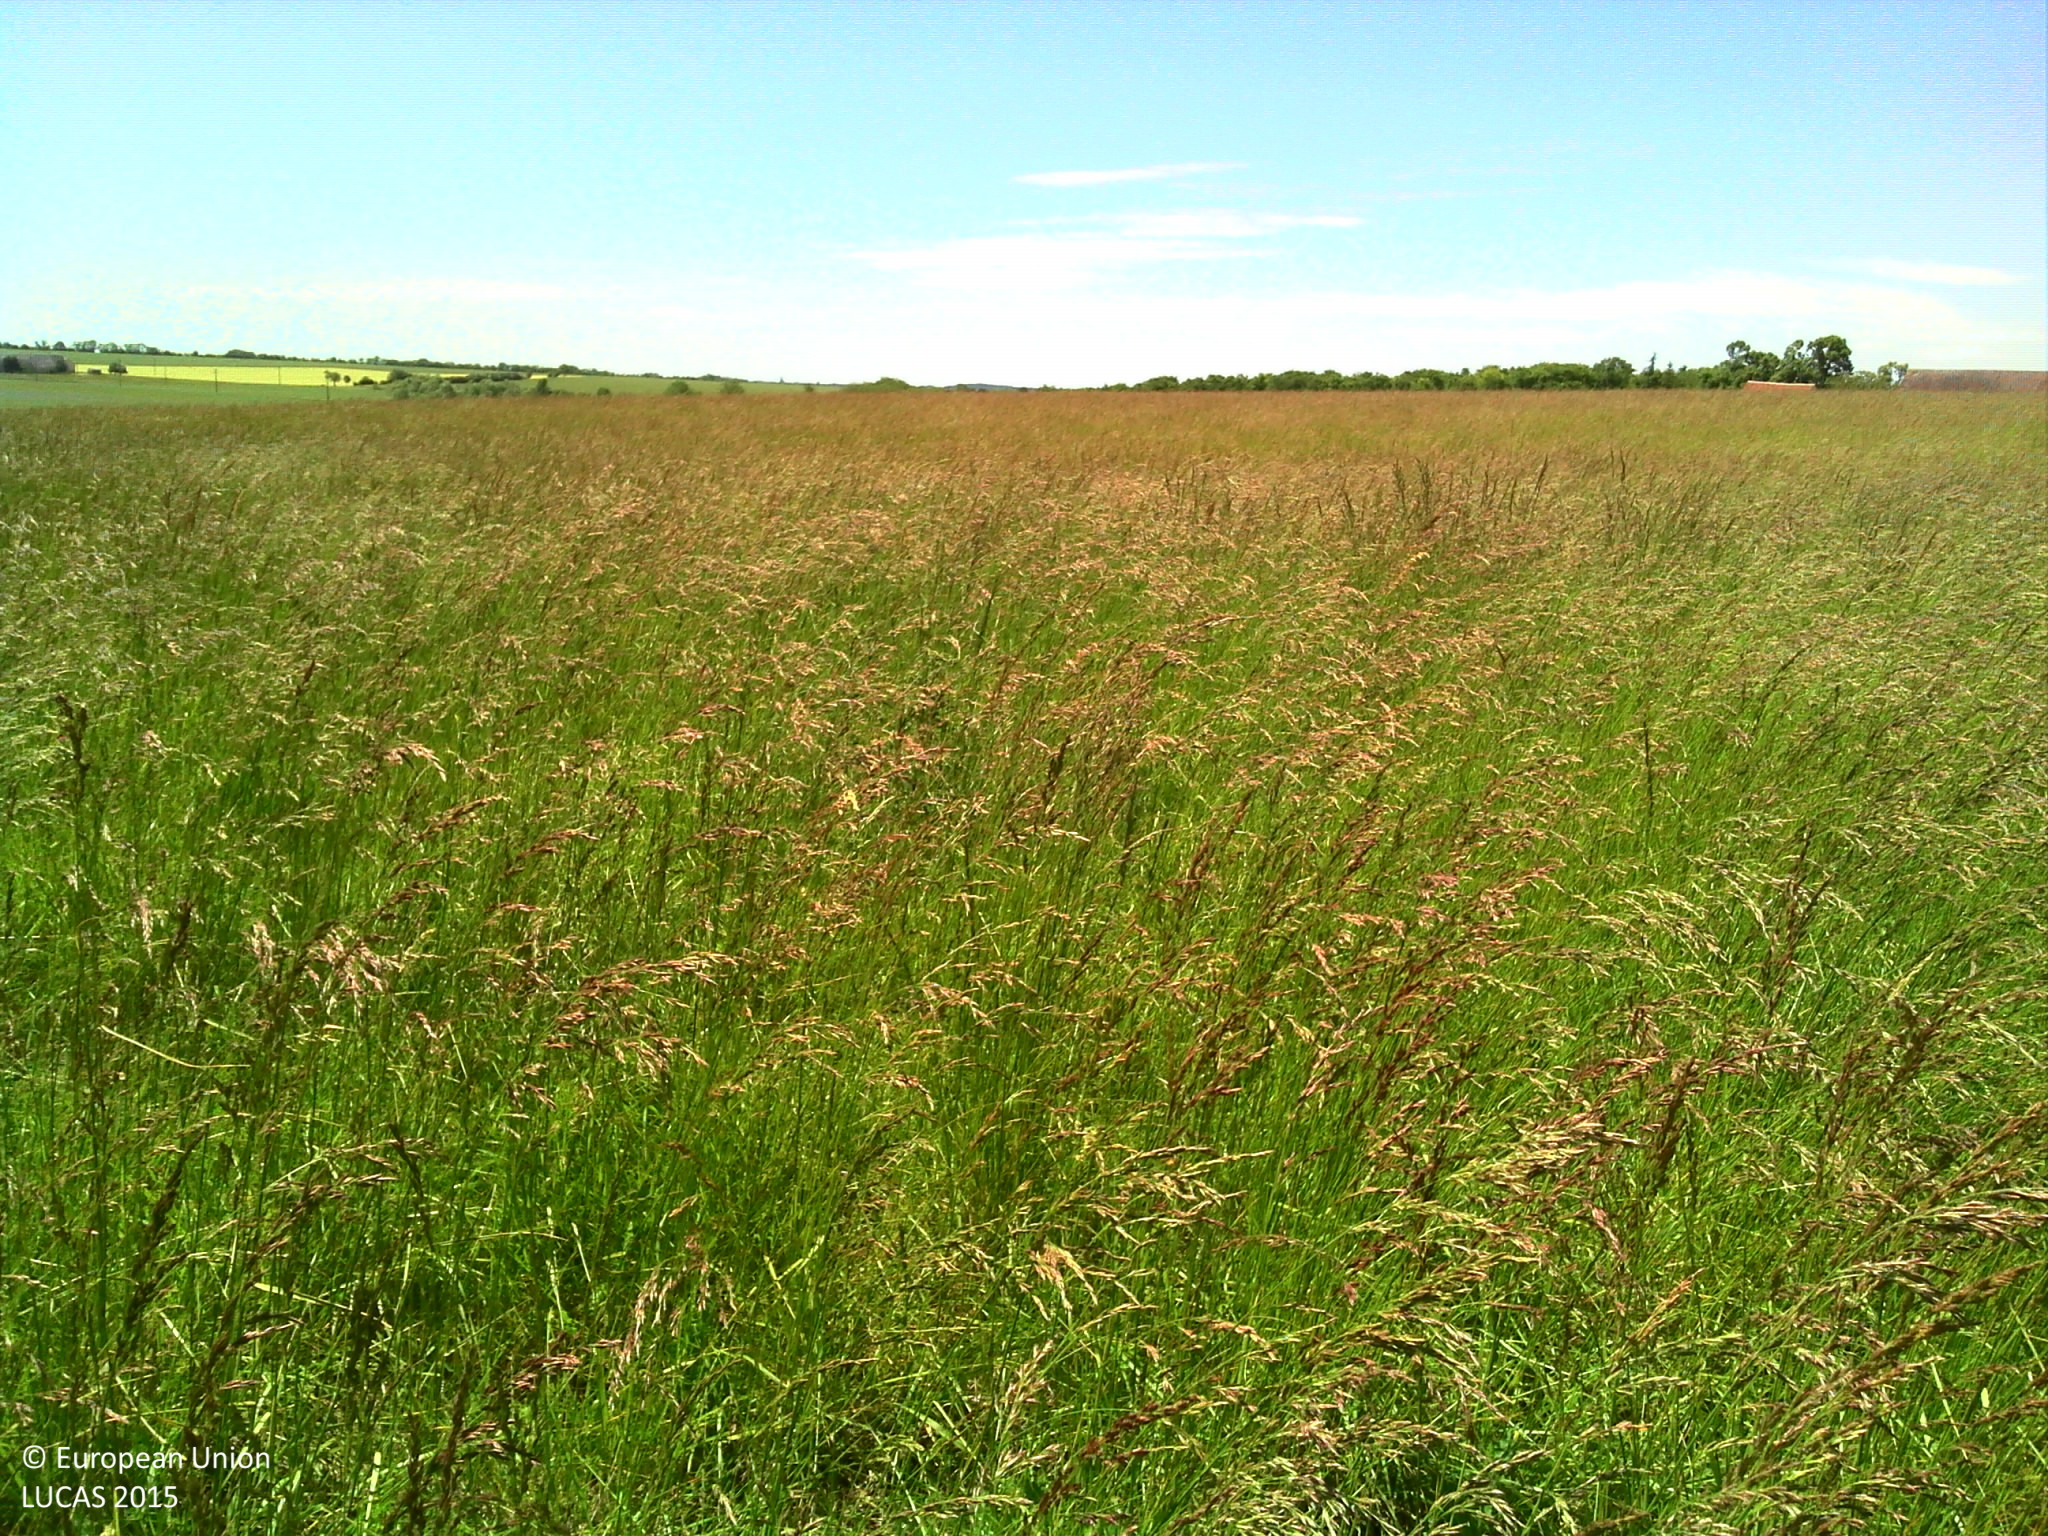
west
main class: Grassland
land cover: Grassland without tree/shrub cover
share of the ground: > 75 %
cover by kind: herbaceous plants 100 %
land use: Agriculture (excluding fallow land and kitchen gardens)
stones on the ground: 10 - 25 %
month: June
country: FR
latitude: 47.0642
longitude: 2.7659
